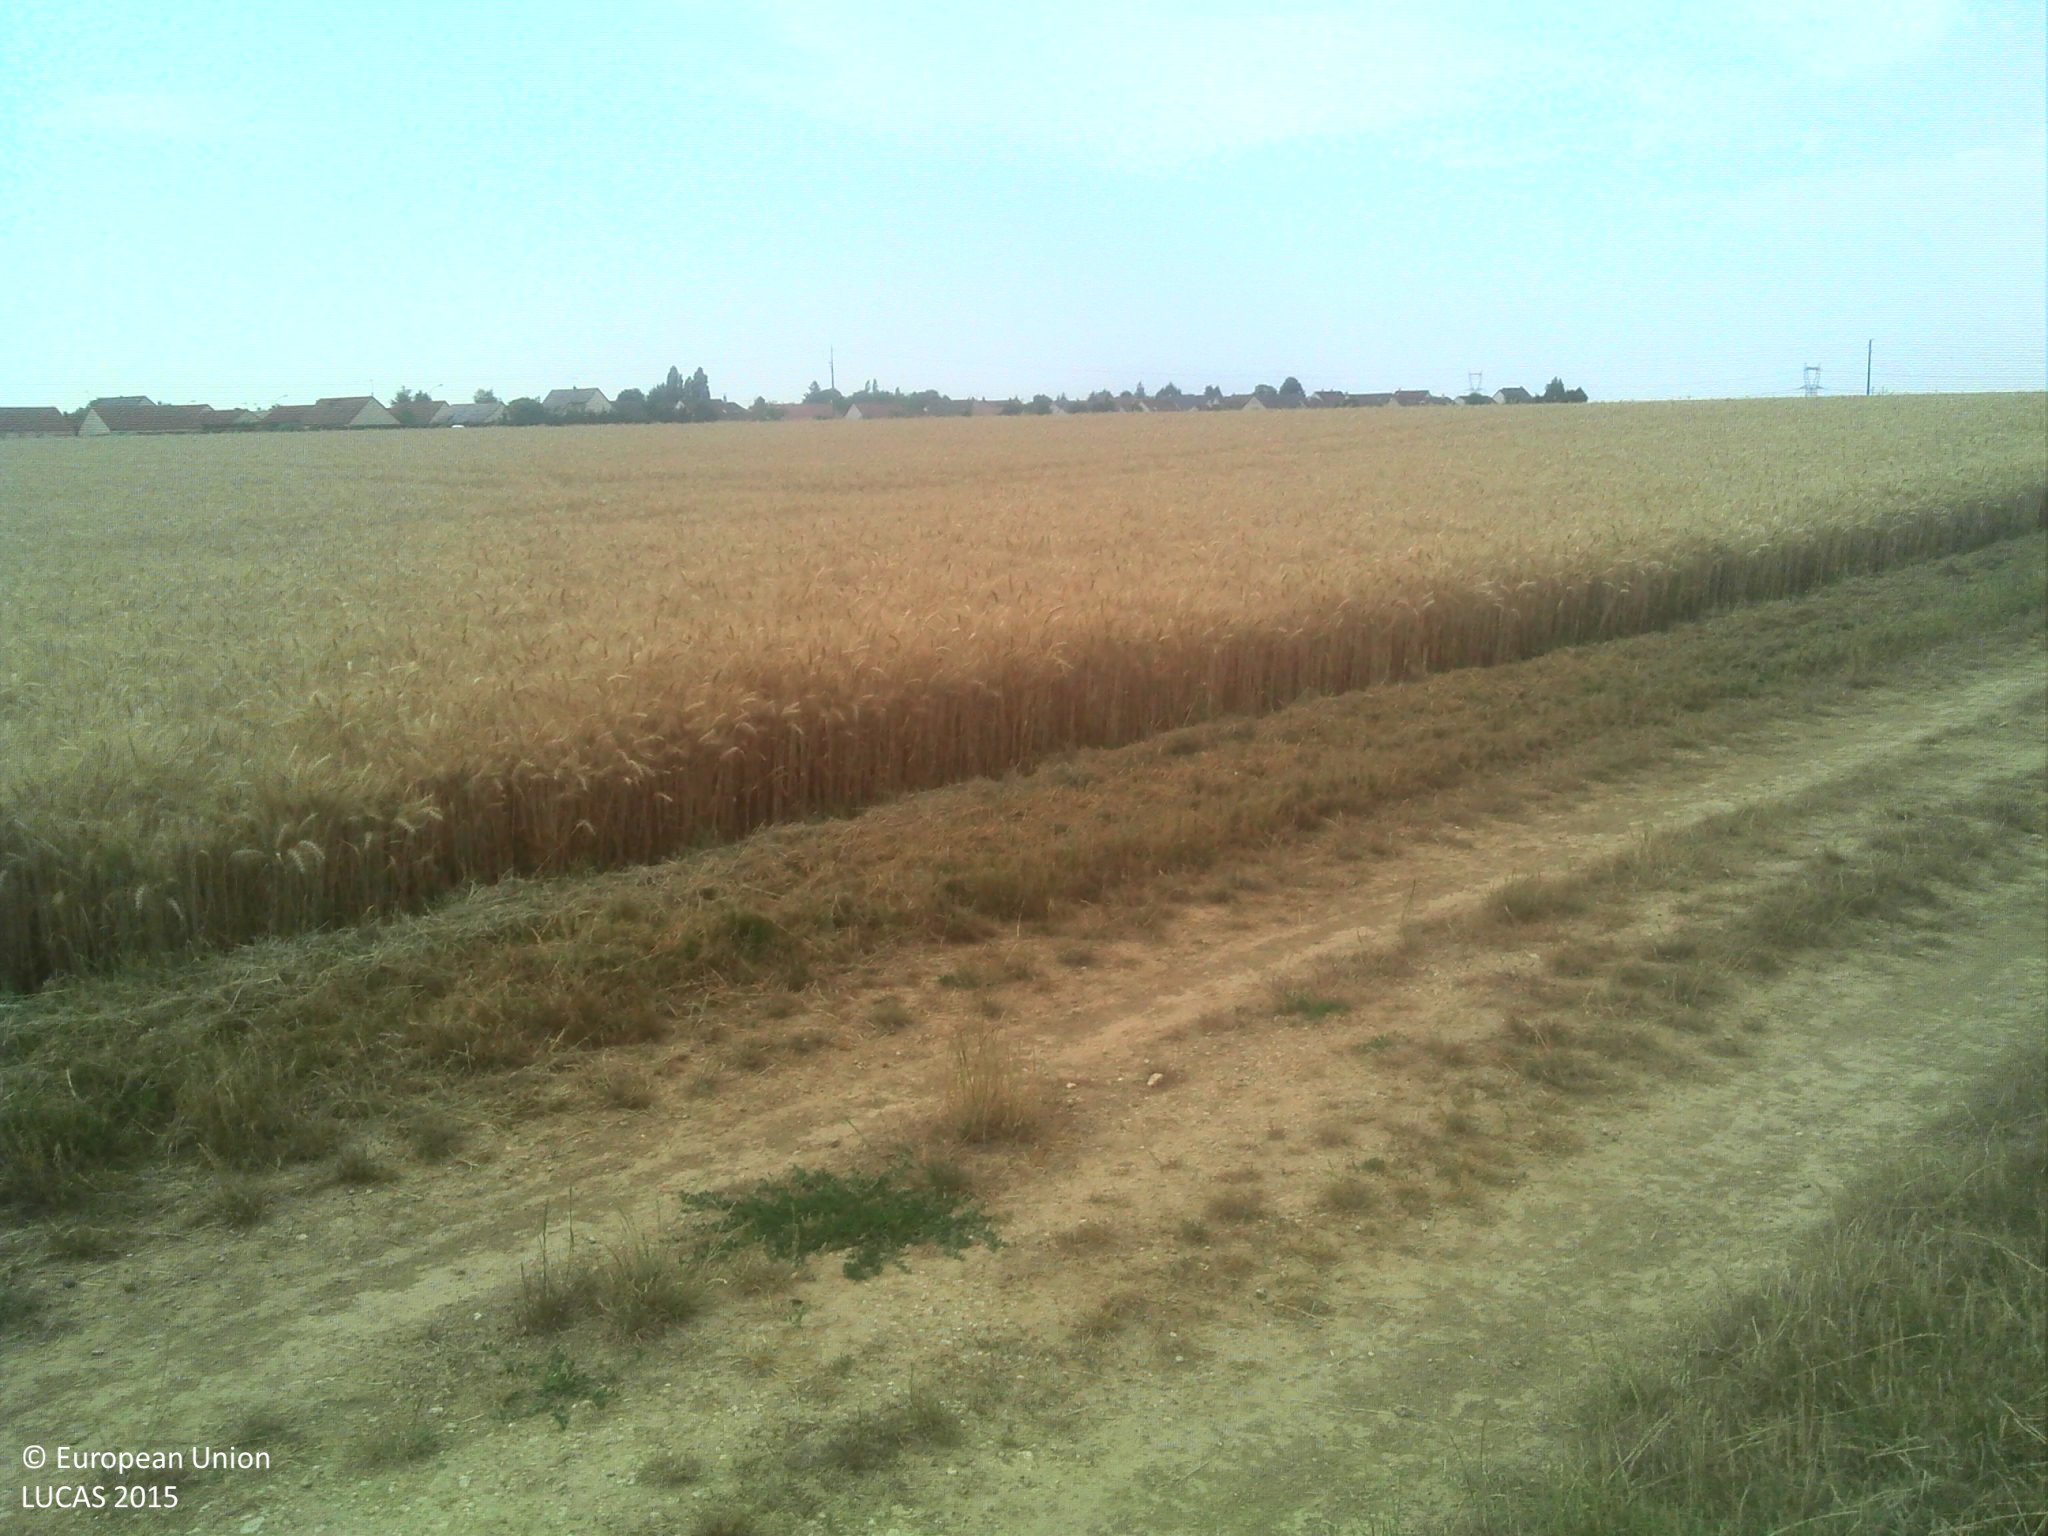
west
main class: Cropland
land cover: Durum wheat
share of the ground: > 75 %
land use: Agriculture (excluding fallow land and kitchen gardens)
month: July
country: FR
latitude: 47.6274
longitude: 1.3214
